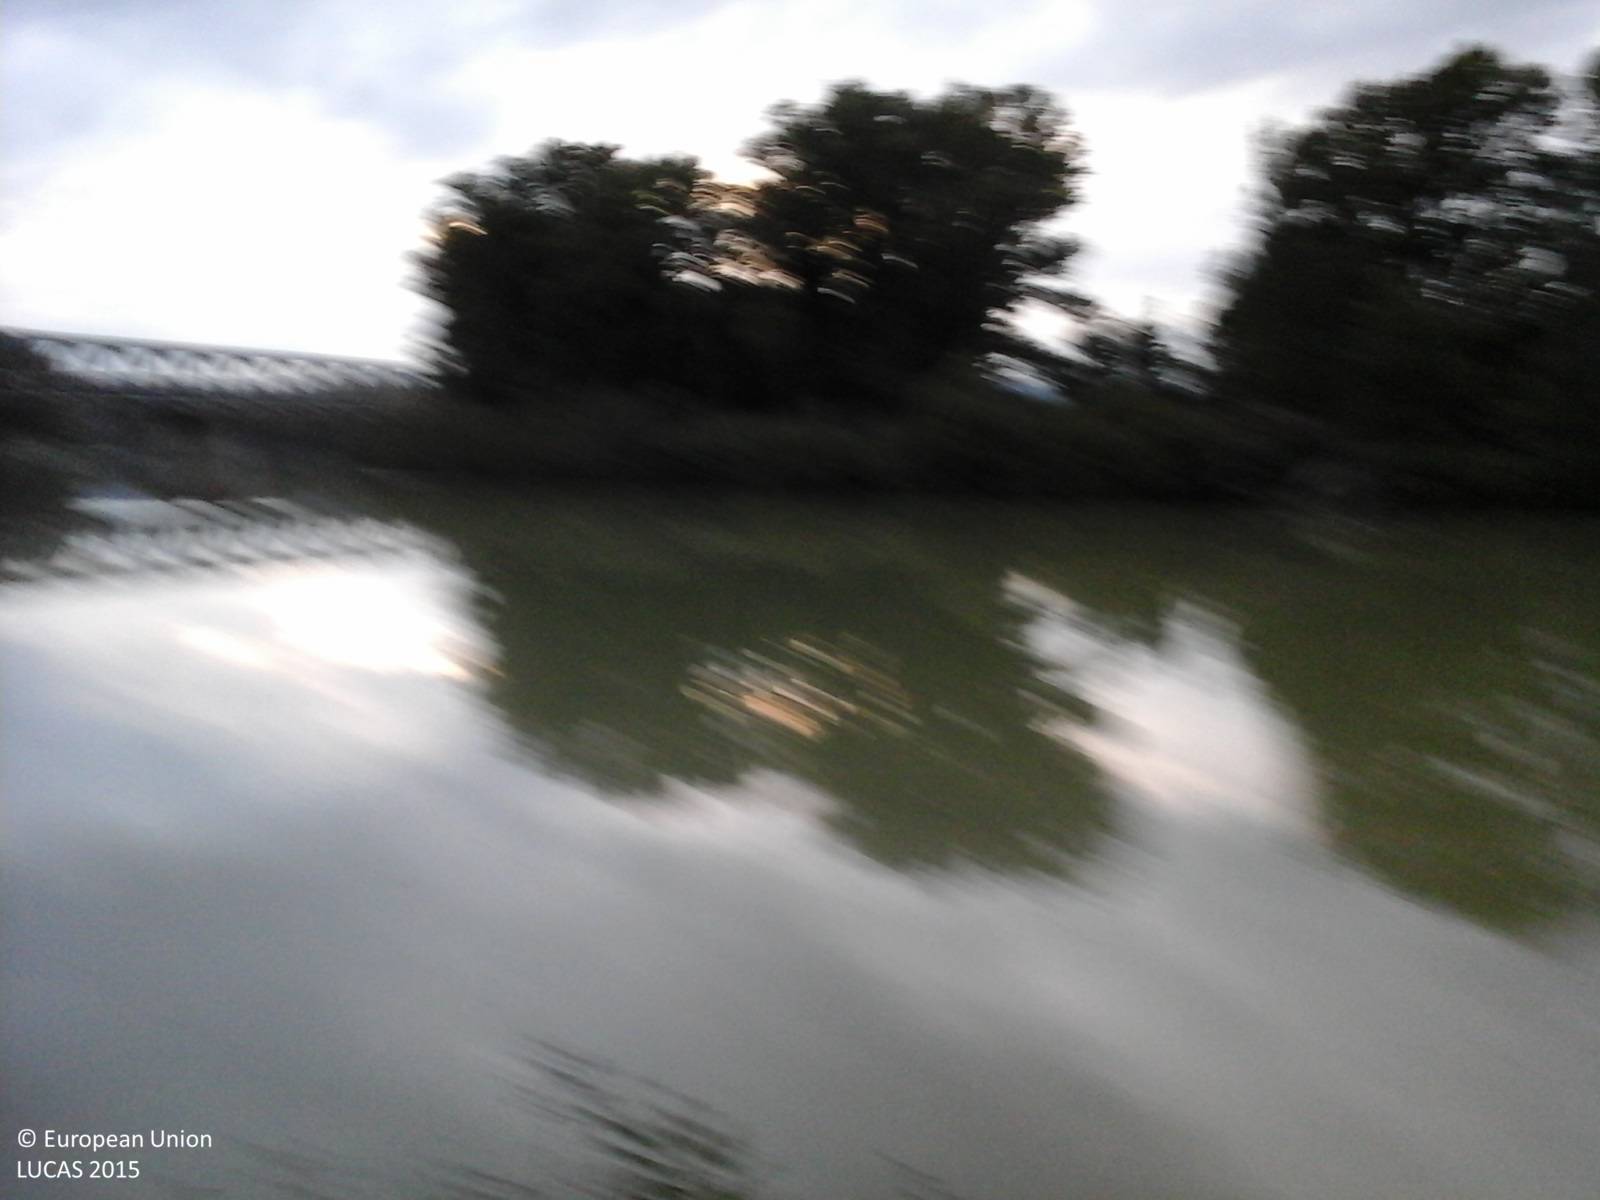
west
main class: Woodland
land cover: Broadleaved woodland
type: floodplain forest
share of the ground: > 75 %
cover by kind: broadleaved forest trees 95 %, shrubs 5 %
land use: Abandoned areas
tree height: > 5 m
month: October
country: IT
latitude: 42.6291
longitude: 12.2485
